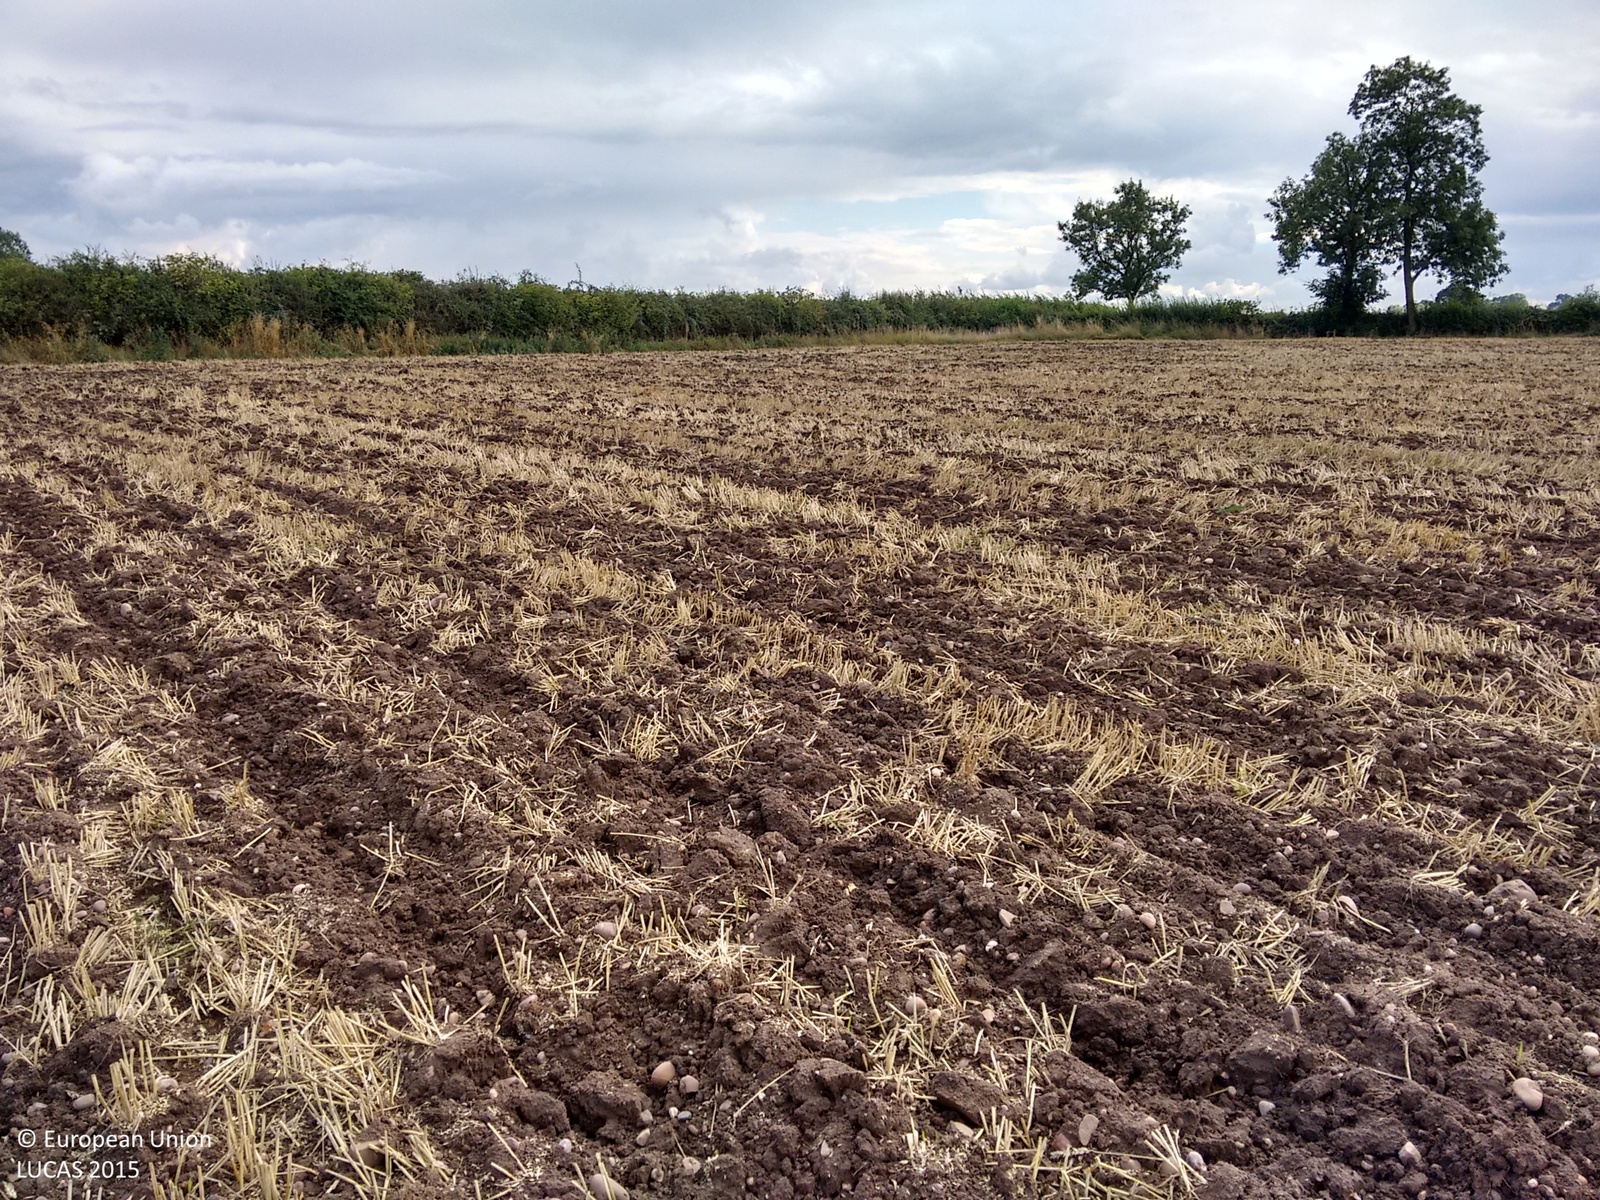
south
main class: Cropland
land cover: Common wheat
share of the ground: > 75 %
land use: Agriculture (excluding fallow land and kitchen gardens)
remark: Harvested field
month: September
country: GB
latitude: 52.5443
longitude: -1.2990
